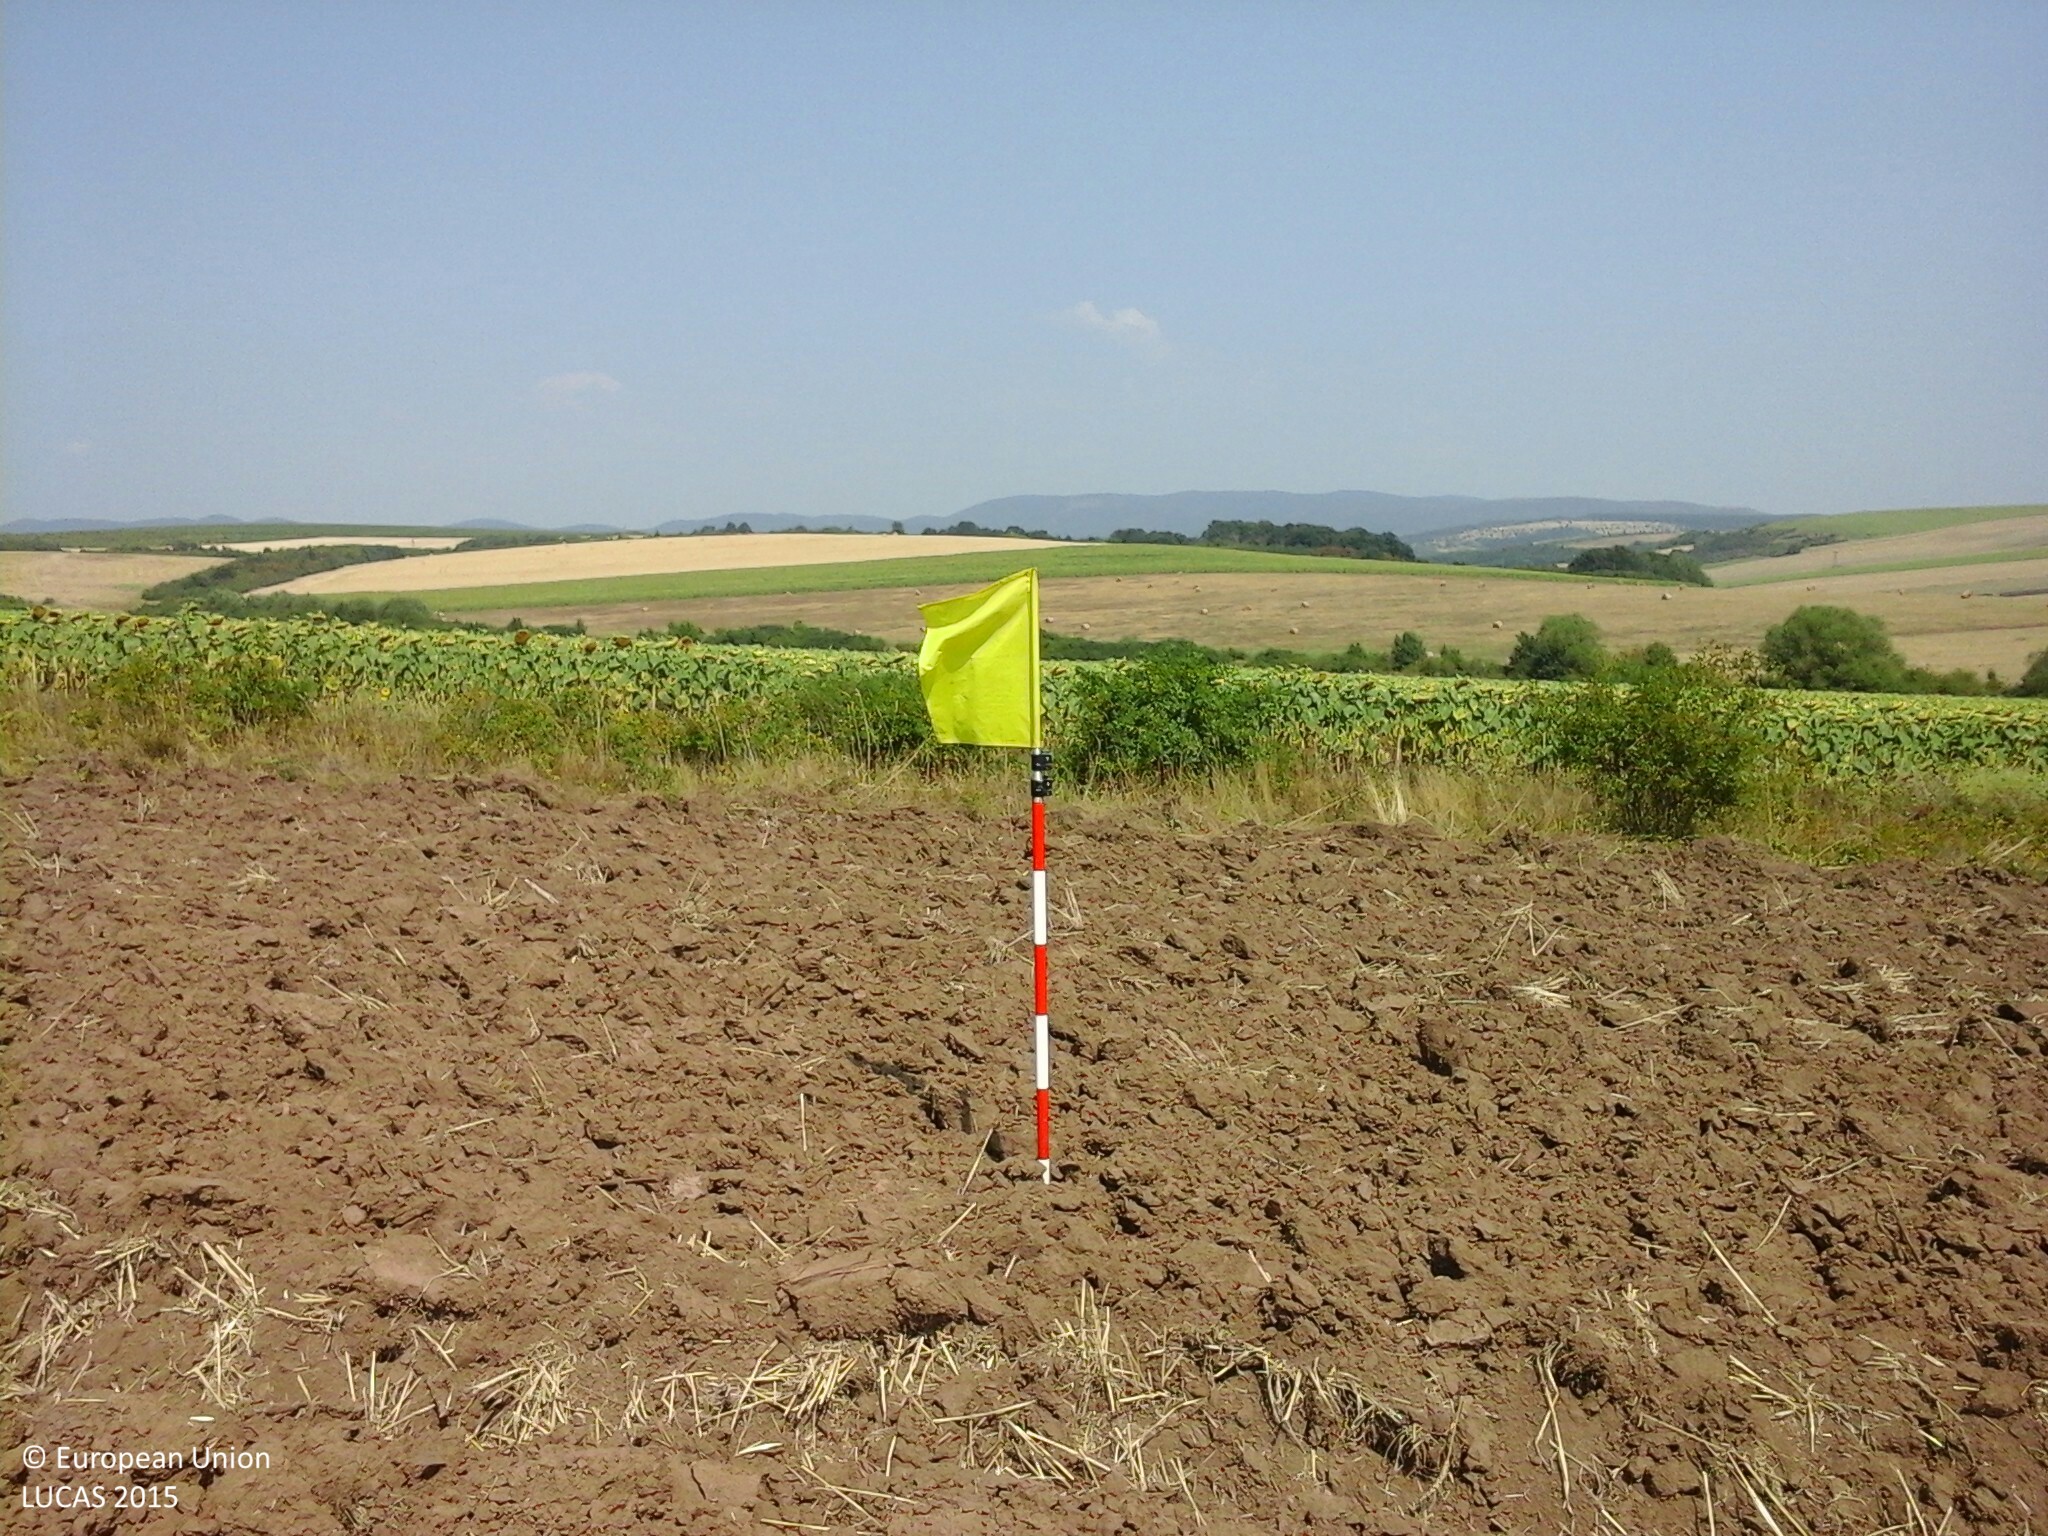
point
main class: Cropland
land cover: Common wheat
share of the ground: < 10 %
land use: Agriculture (excluding fallow land and kitchen gardens)
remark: Harvested field
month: August
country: HU
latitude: 47.9368
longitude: 20.7040
